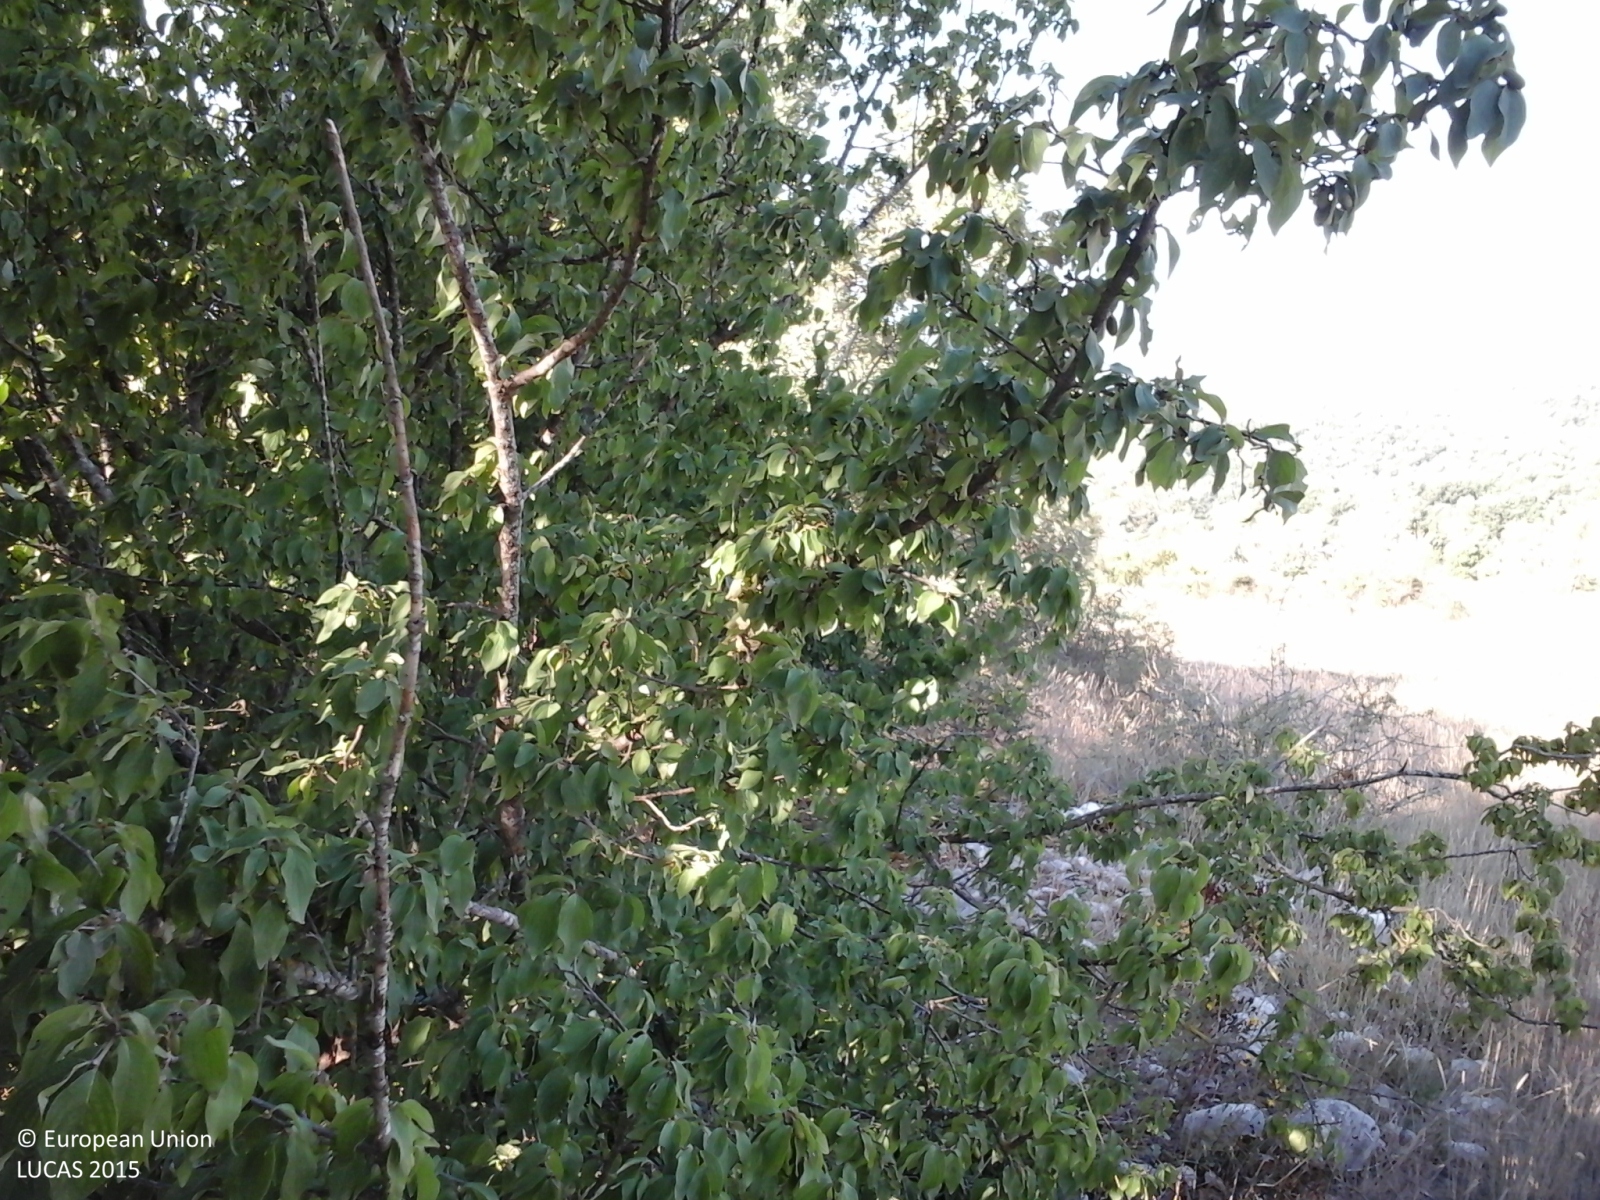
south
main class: Grassland
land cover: Spontaneously vegetated surfaces
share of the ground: > 75 %
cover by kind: herbaceous plants 100 %
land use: Agriculture (excluding fallow land and kitchen gardens)
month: August
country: IT
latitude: 42.1674
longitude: 13.2693
